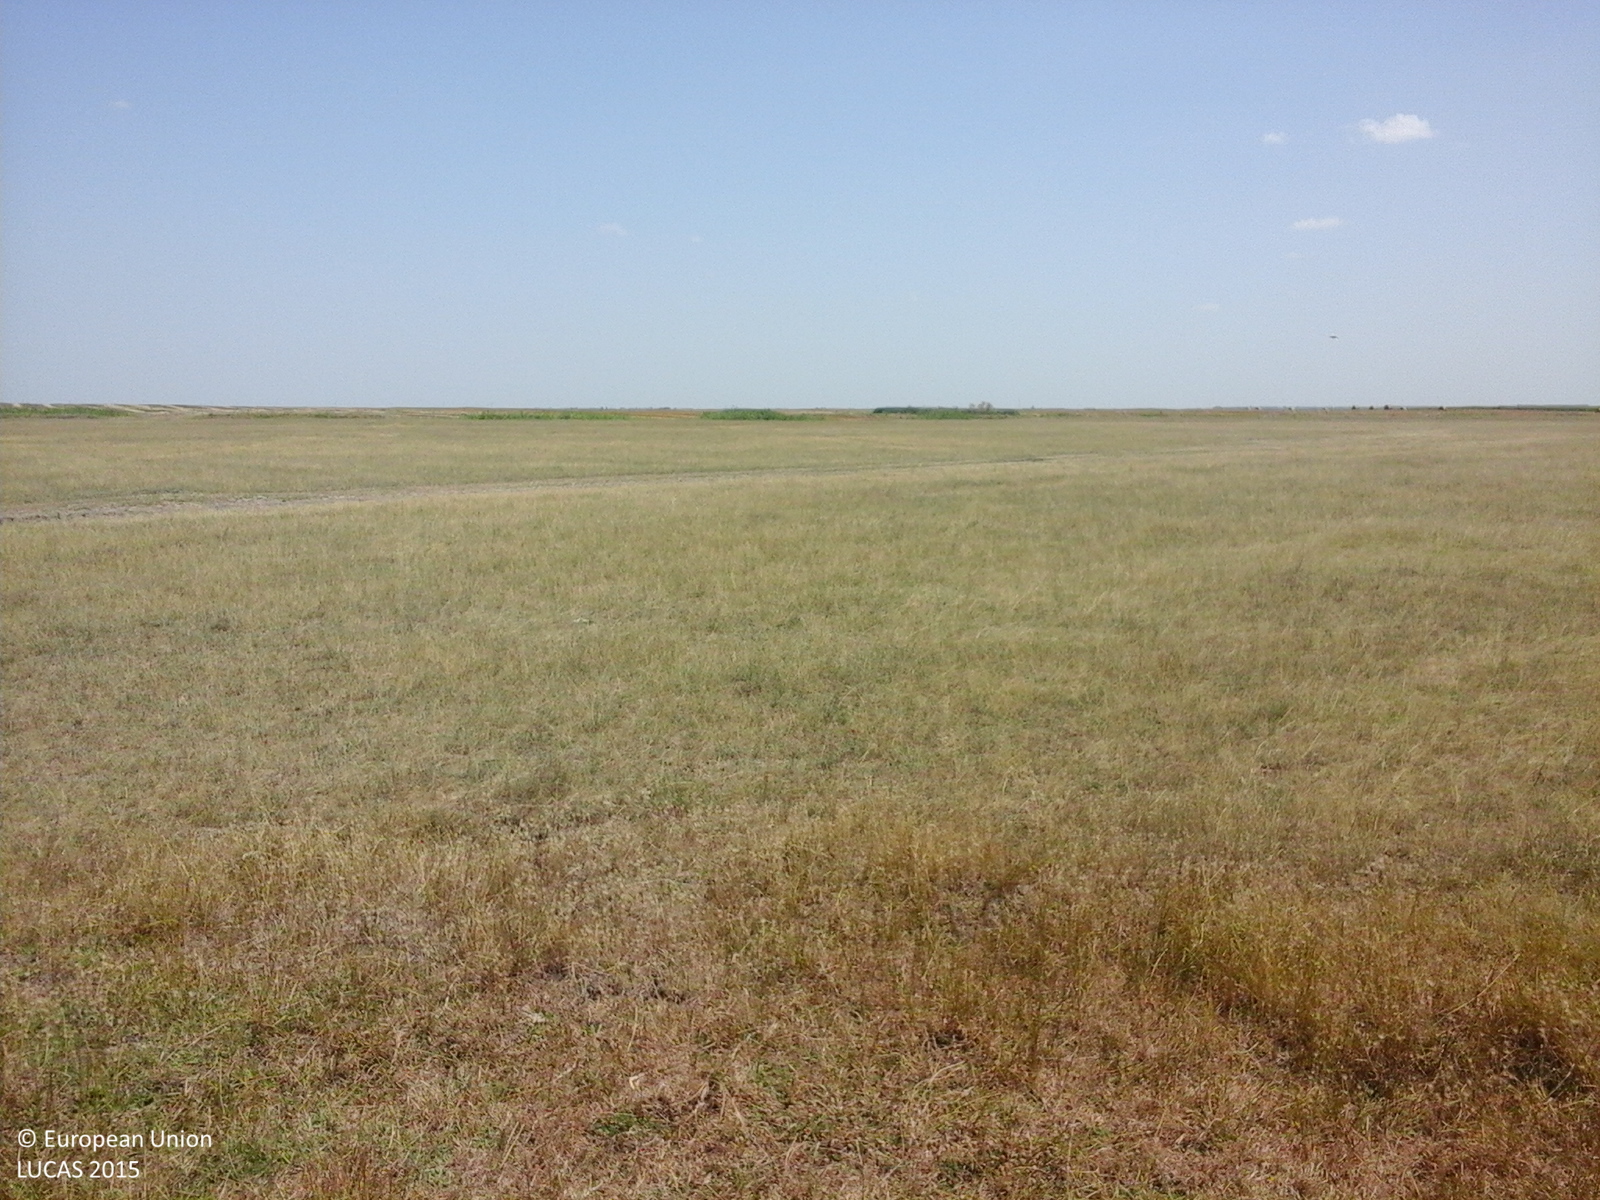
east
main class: Grassland
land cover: Grassland without tree/shrub cover
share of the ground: > 75 %
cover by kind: herbaceous plants 100 %
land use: Agriculture (excluding fallow land and kitchen gardens)
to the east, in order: Grassland without tree/shrub cover; Tracks; Grassland without tree/shrub cover; Ditches and canals; Common wheat
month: July
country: RO
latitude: 45.0496
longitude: 26.6697
